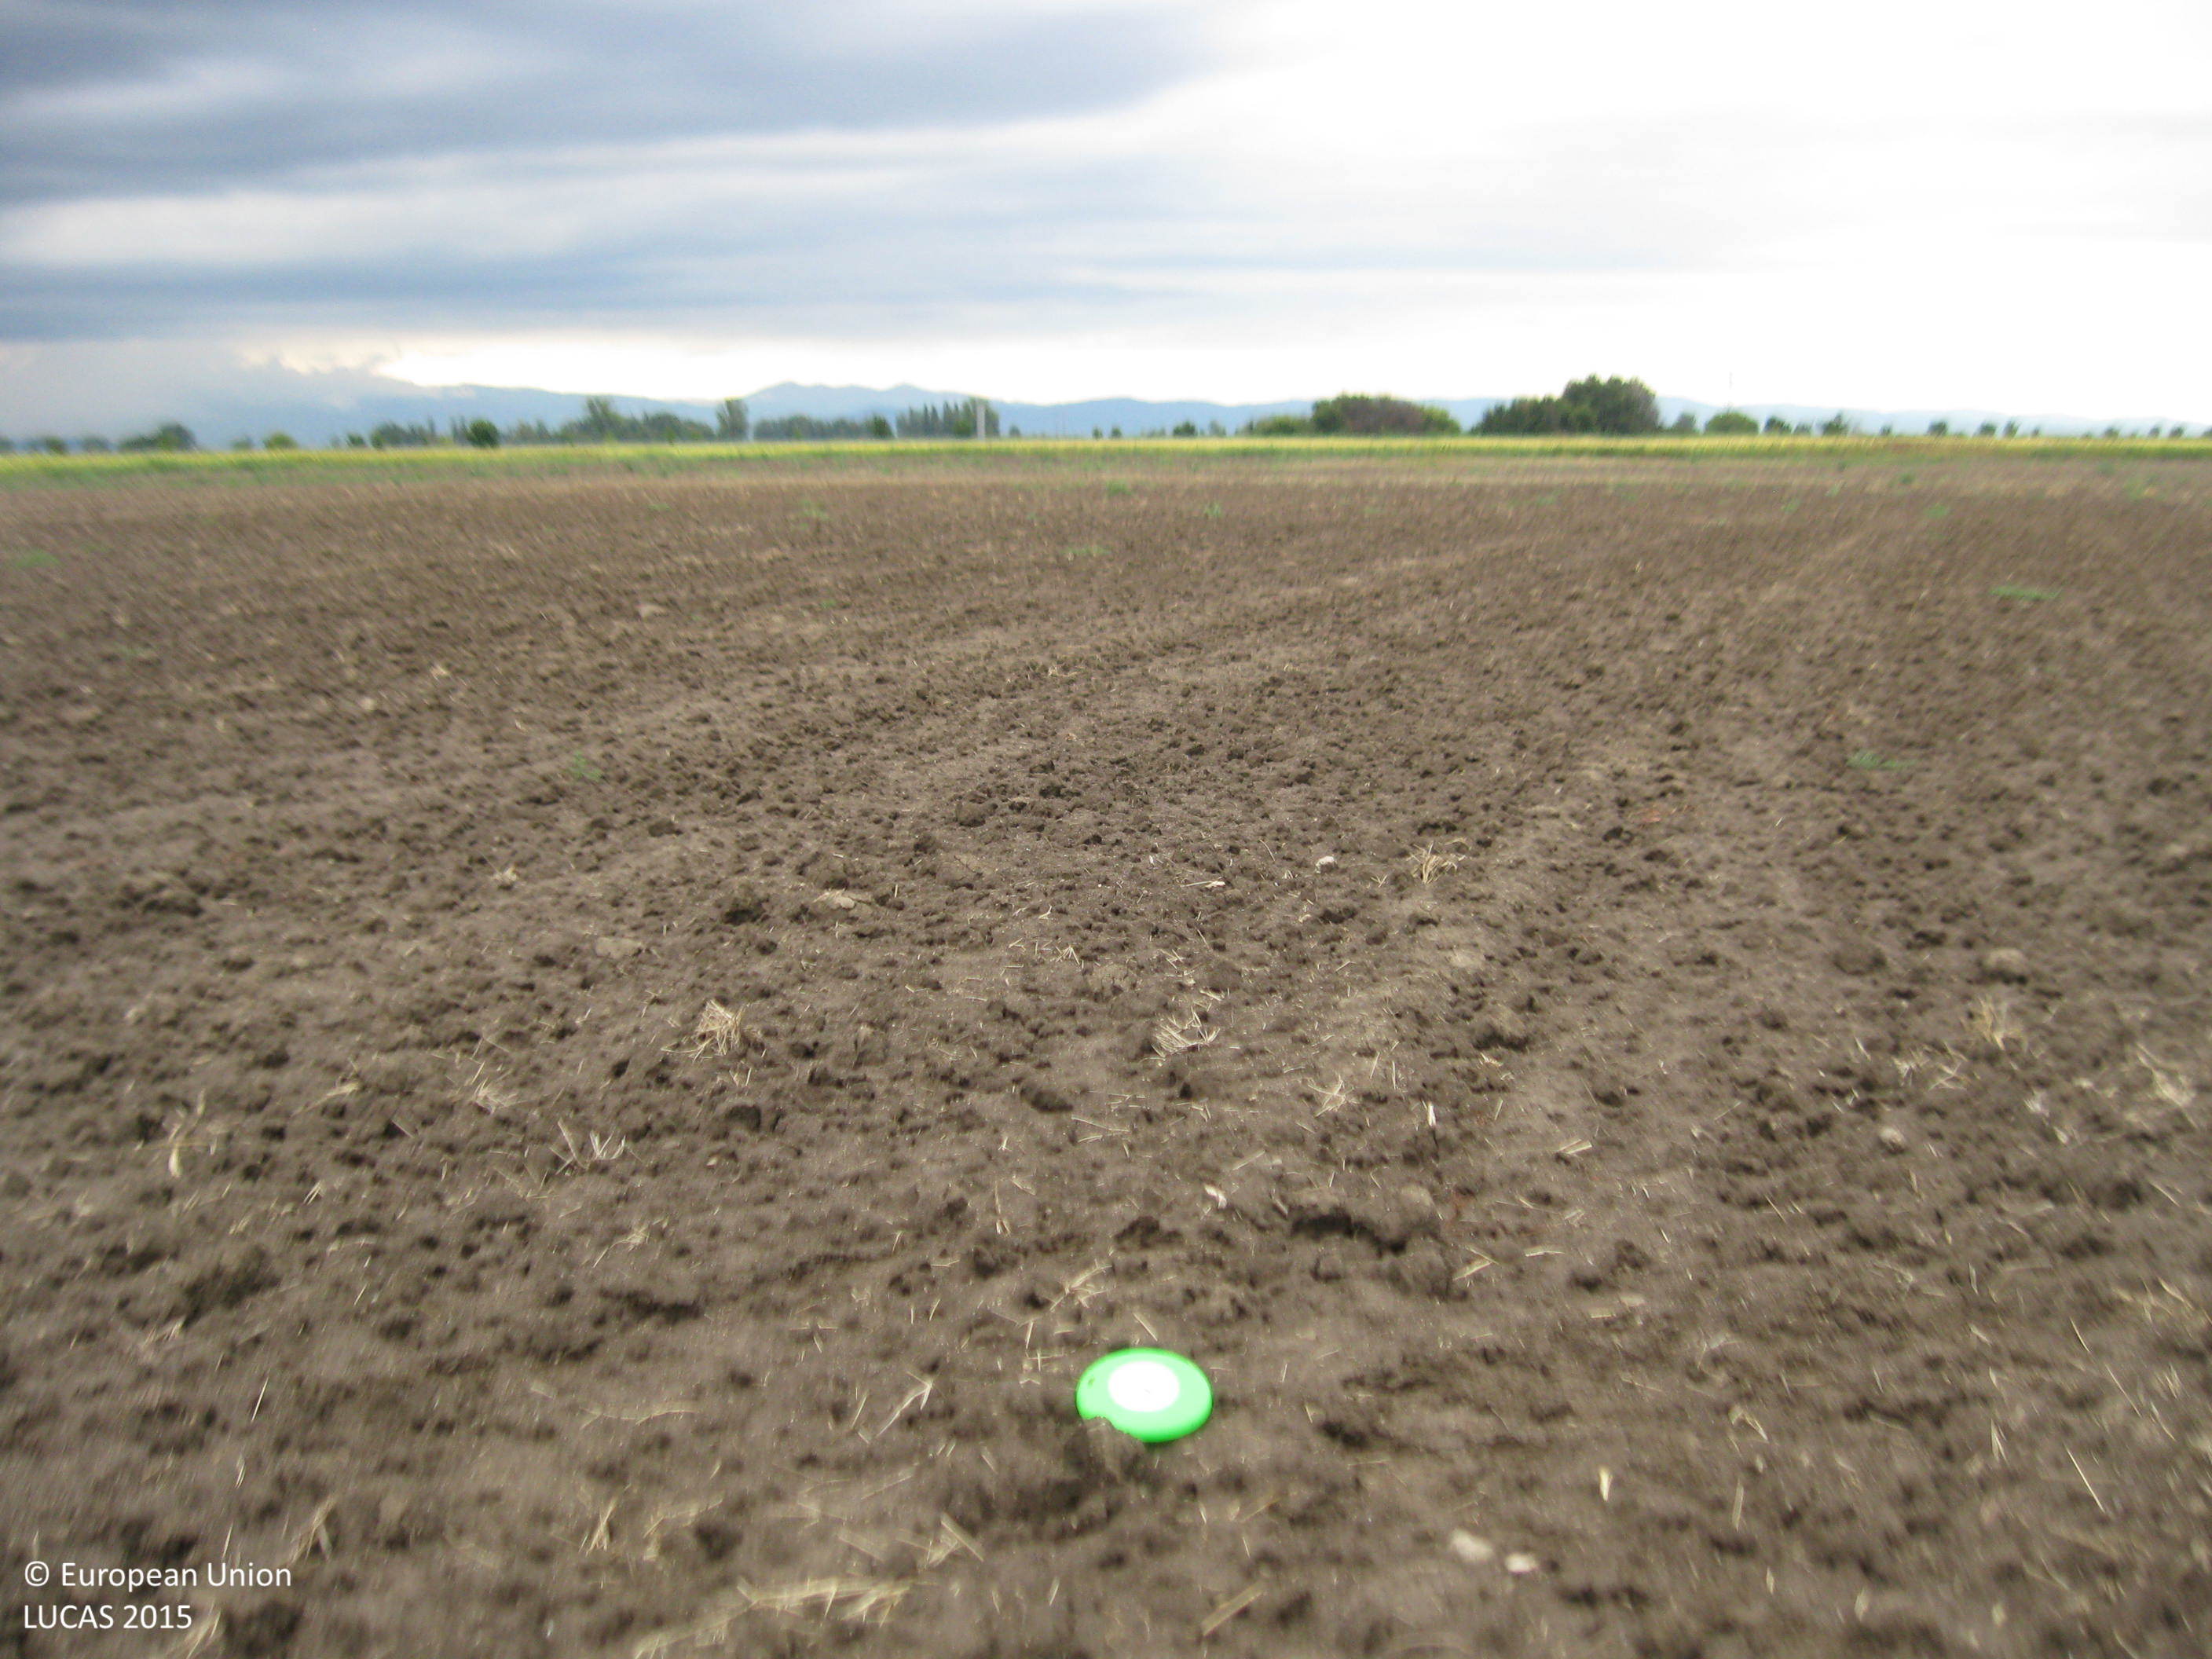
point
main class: Cropland
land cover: Common wheat
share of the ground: < 10 %
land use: Agriculture (excluding fallow land and kitchen gardens)
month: August
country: BG
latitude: 42.2096
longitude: 24.7447
